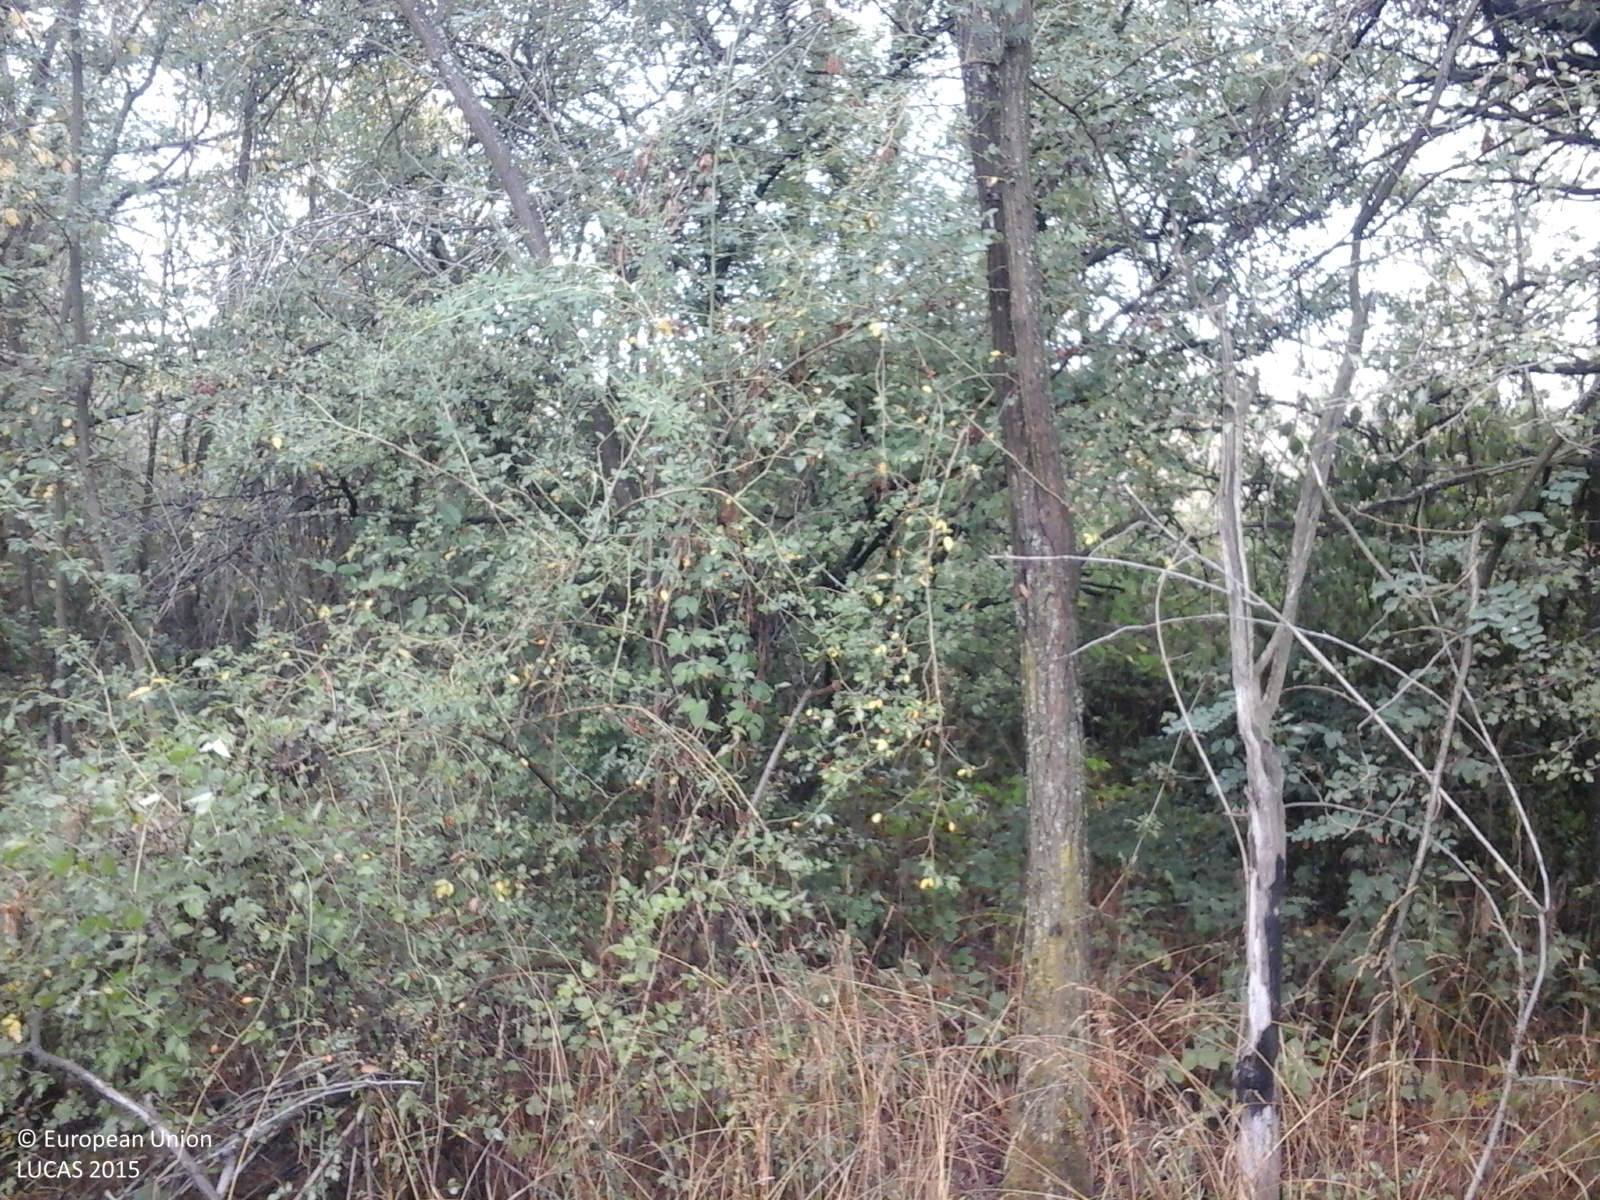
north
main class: Woodland
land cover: Broadleaved woodland
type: exotic forest
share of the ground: > 75 %
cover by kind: broadleaved forest trees 100 %
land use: Forestry
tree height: > 5 m
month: August
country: RO
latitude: 44.8962
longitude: 22.1038
